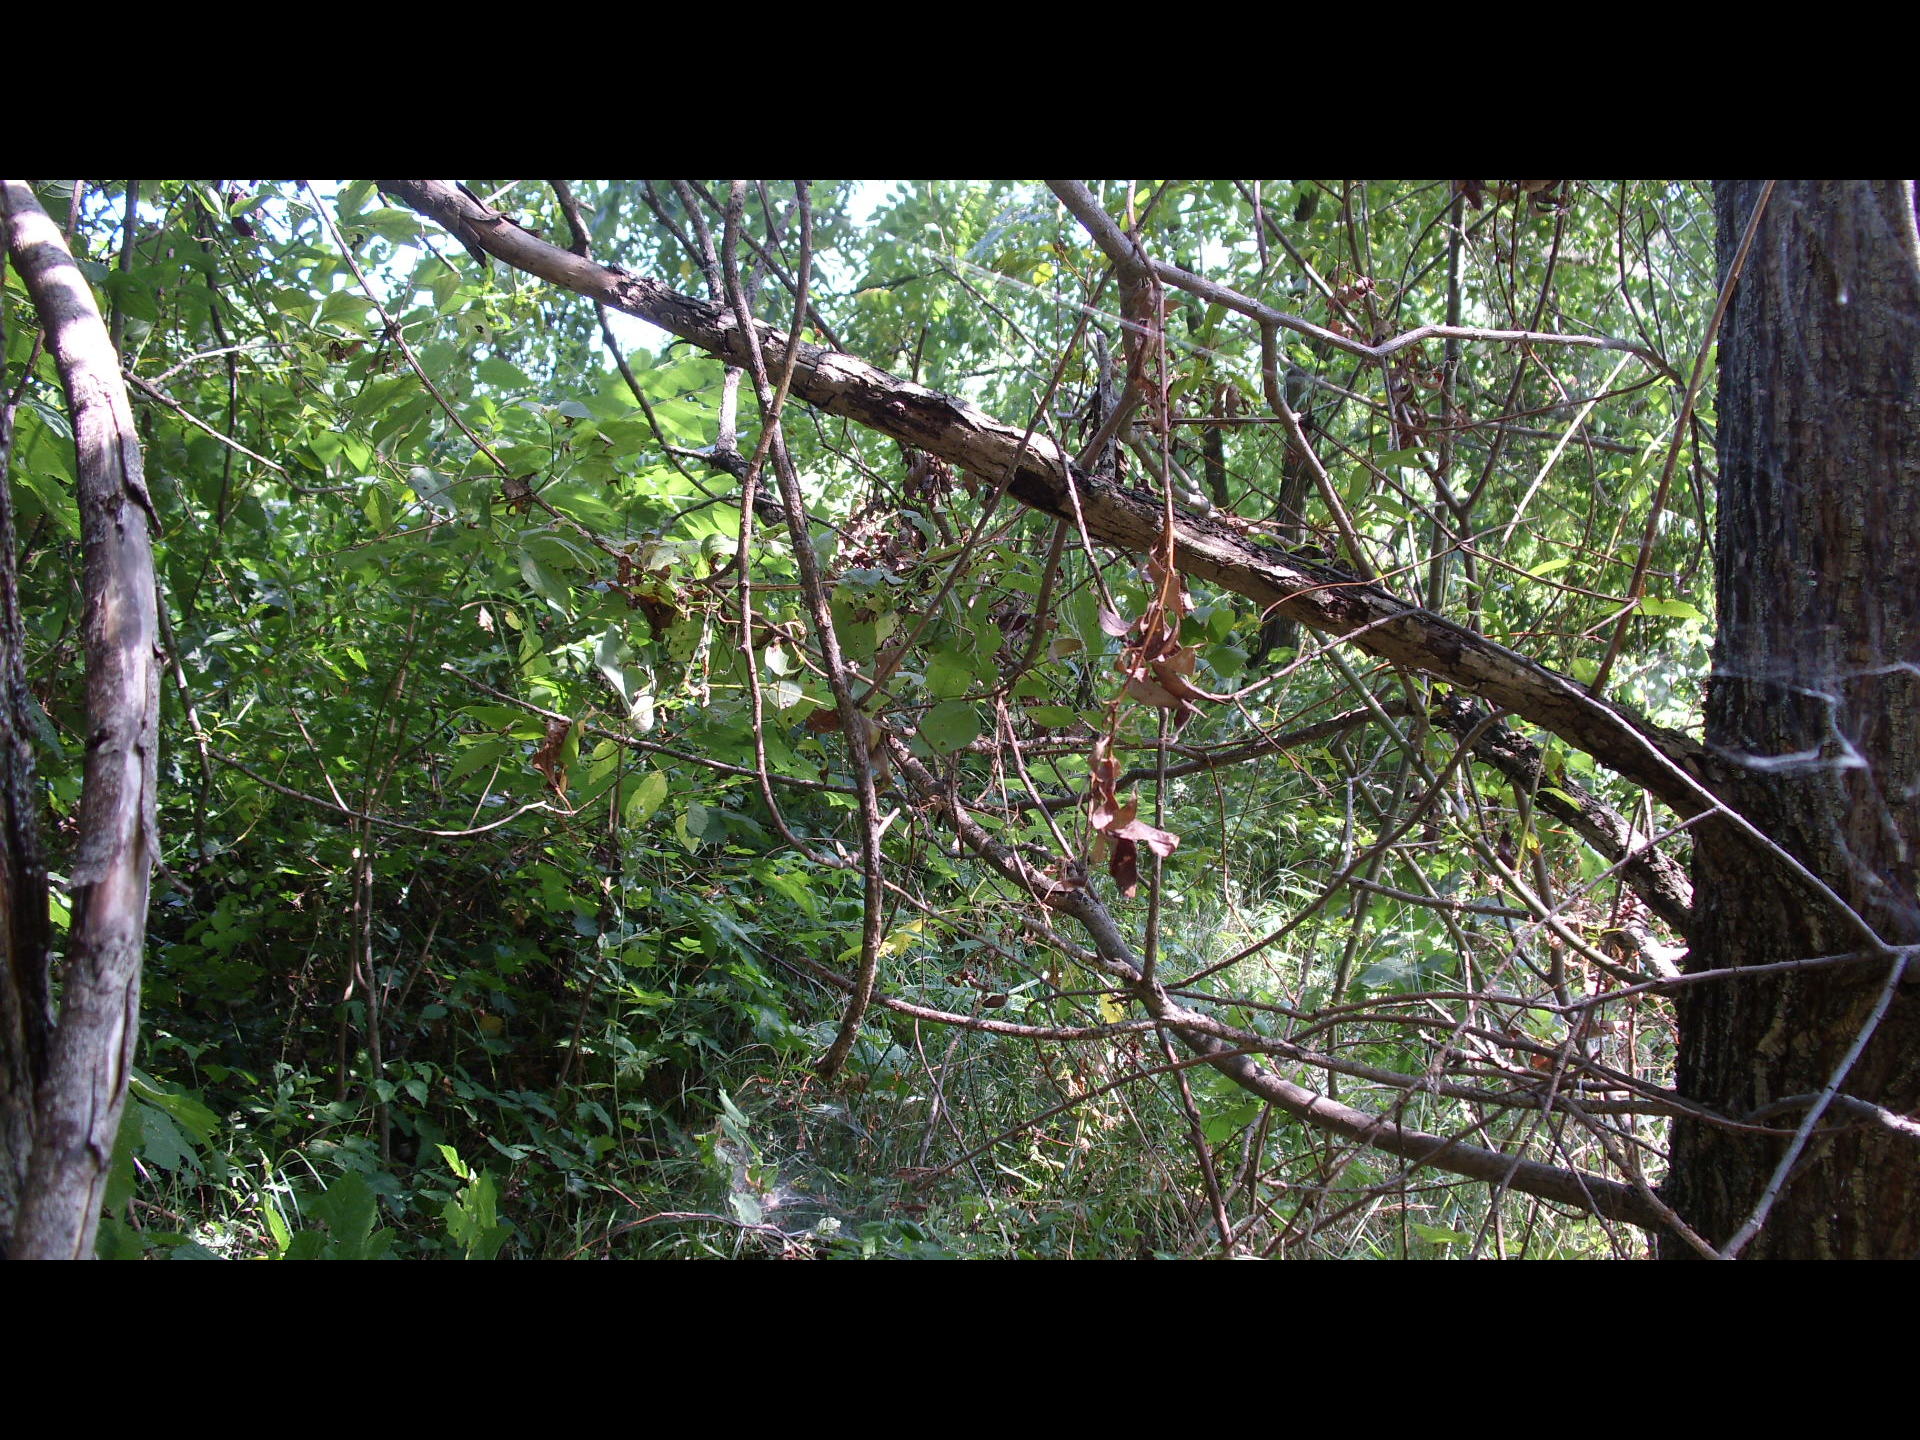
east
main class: Woodland
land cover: Broadleaved woodland
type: thermophilous deciduous forest
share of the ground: > 75 %
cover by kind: broadleaved forest trees 60 %, shrubs 30 %, herbaceous plants 10 %
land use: Forestry
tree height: > 5 m
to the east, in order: Broadleaved woodland; Grassland with sparse tree/shrub cover; Broadleaved woodland; Artificial constructions in urban areas; Grassland with sparse tree/shrub cover; Tracks; Sunflower; Grass margins; Shrubland with sparse tree cover
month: August
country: BG
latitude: 43.2747
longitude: 23.4103
